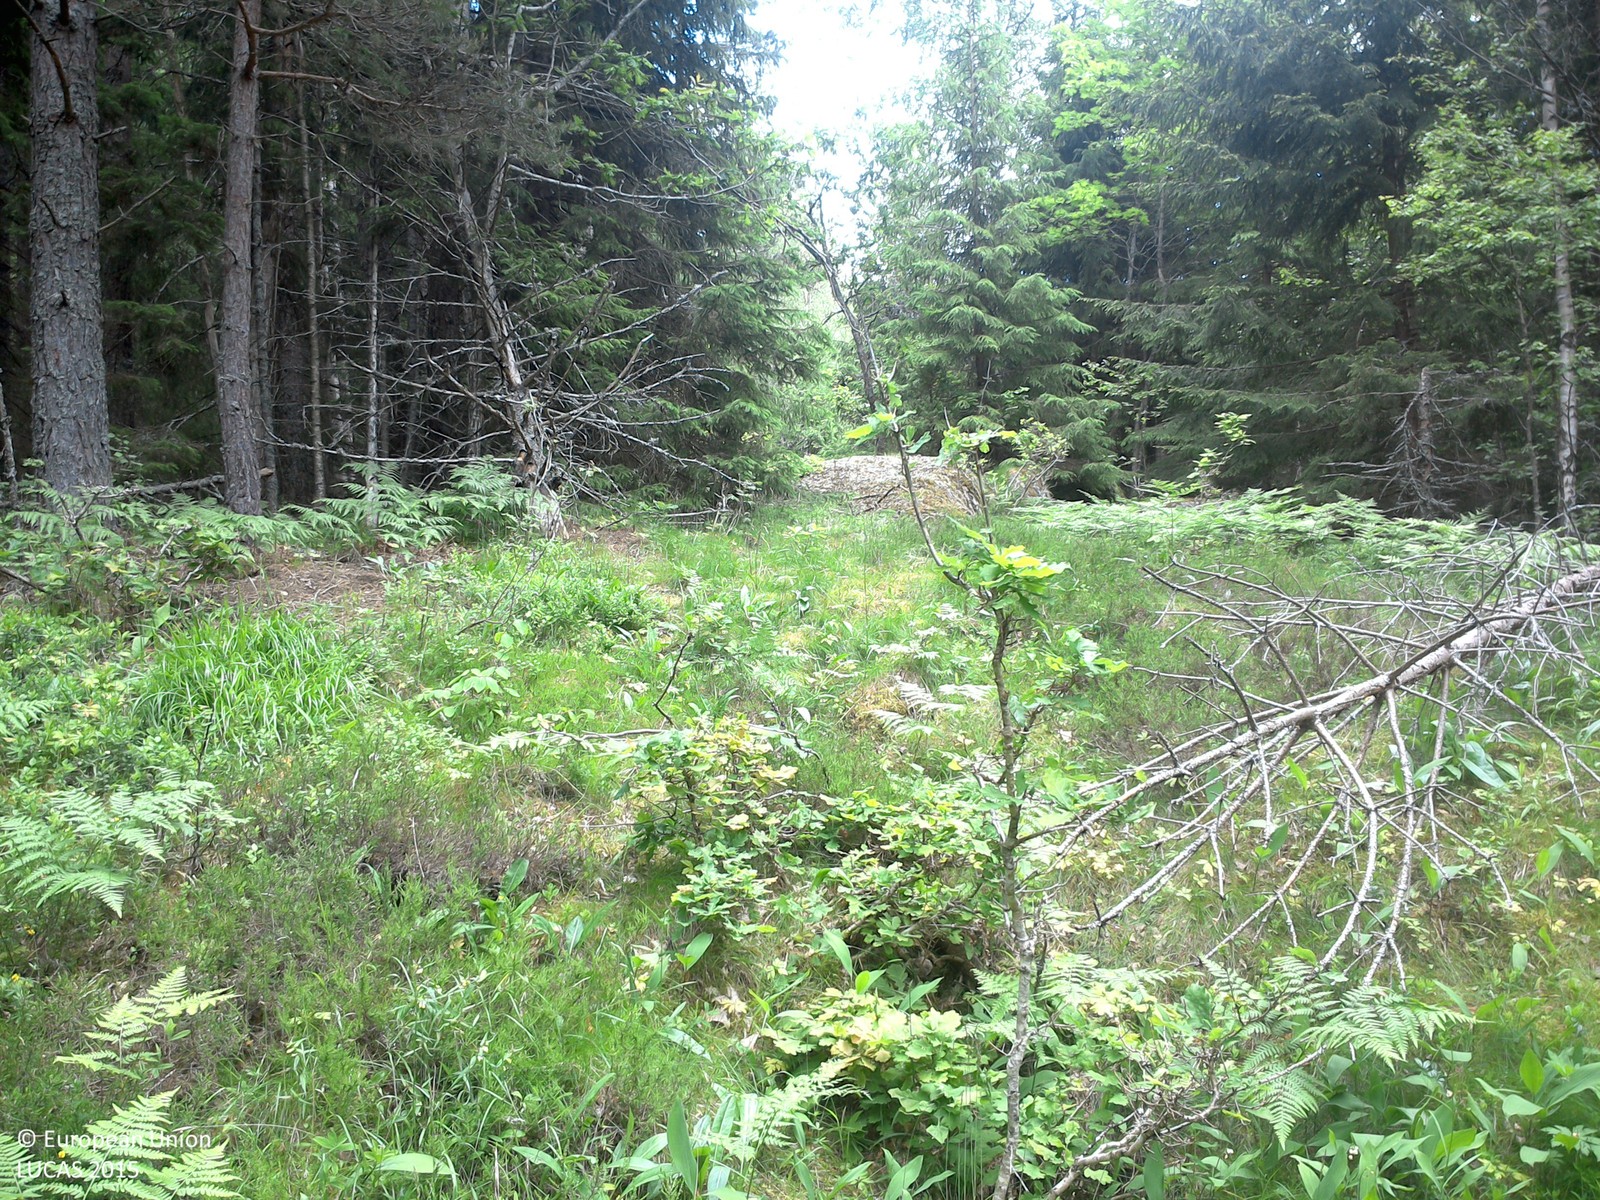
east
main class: Woodland
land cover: Spruce dominated mixed woodland
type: boreal forest
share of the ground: 50 - 75 %
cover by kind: coniferous forest trees 50 %, broadleaved forest trees 20 %, herbaceous plants 15 %, lichens and mosses 15 %
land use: Amenities, museums, leisure
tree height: > 5 m
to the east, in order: Spruce dominated mixed woodland; Broadleaved woodland; Spruce dominated coniferous woodland
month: June
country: SE
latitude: 58.0721
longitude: 15.4712
